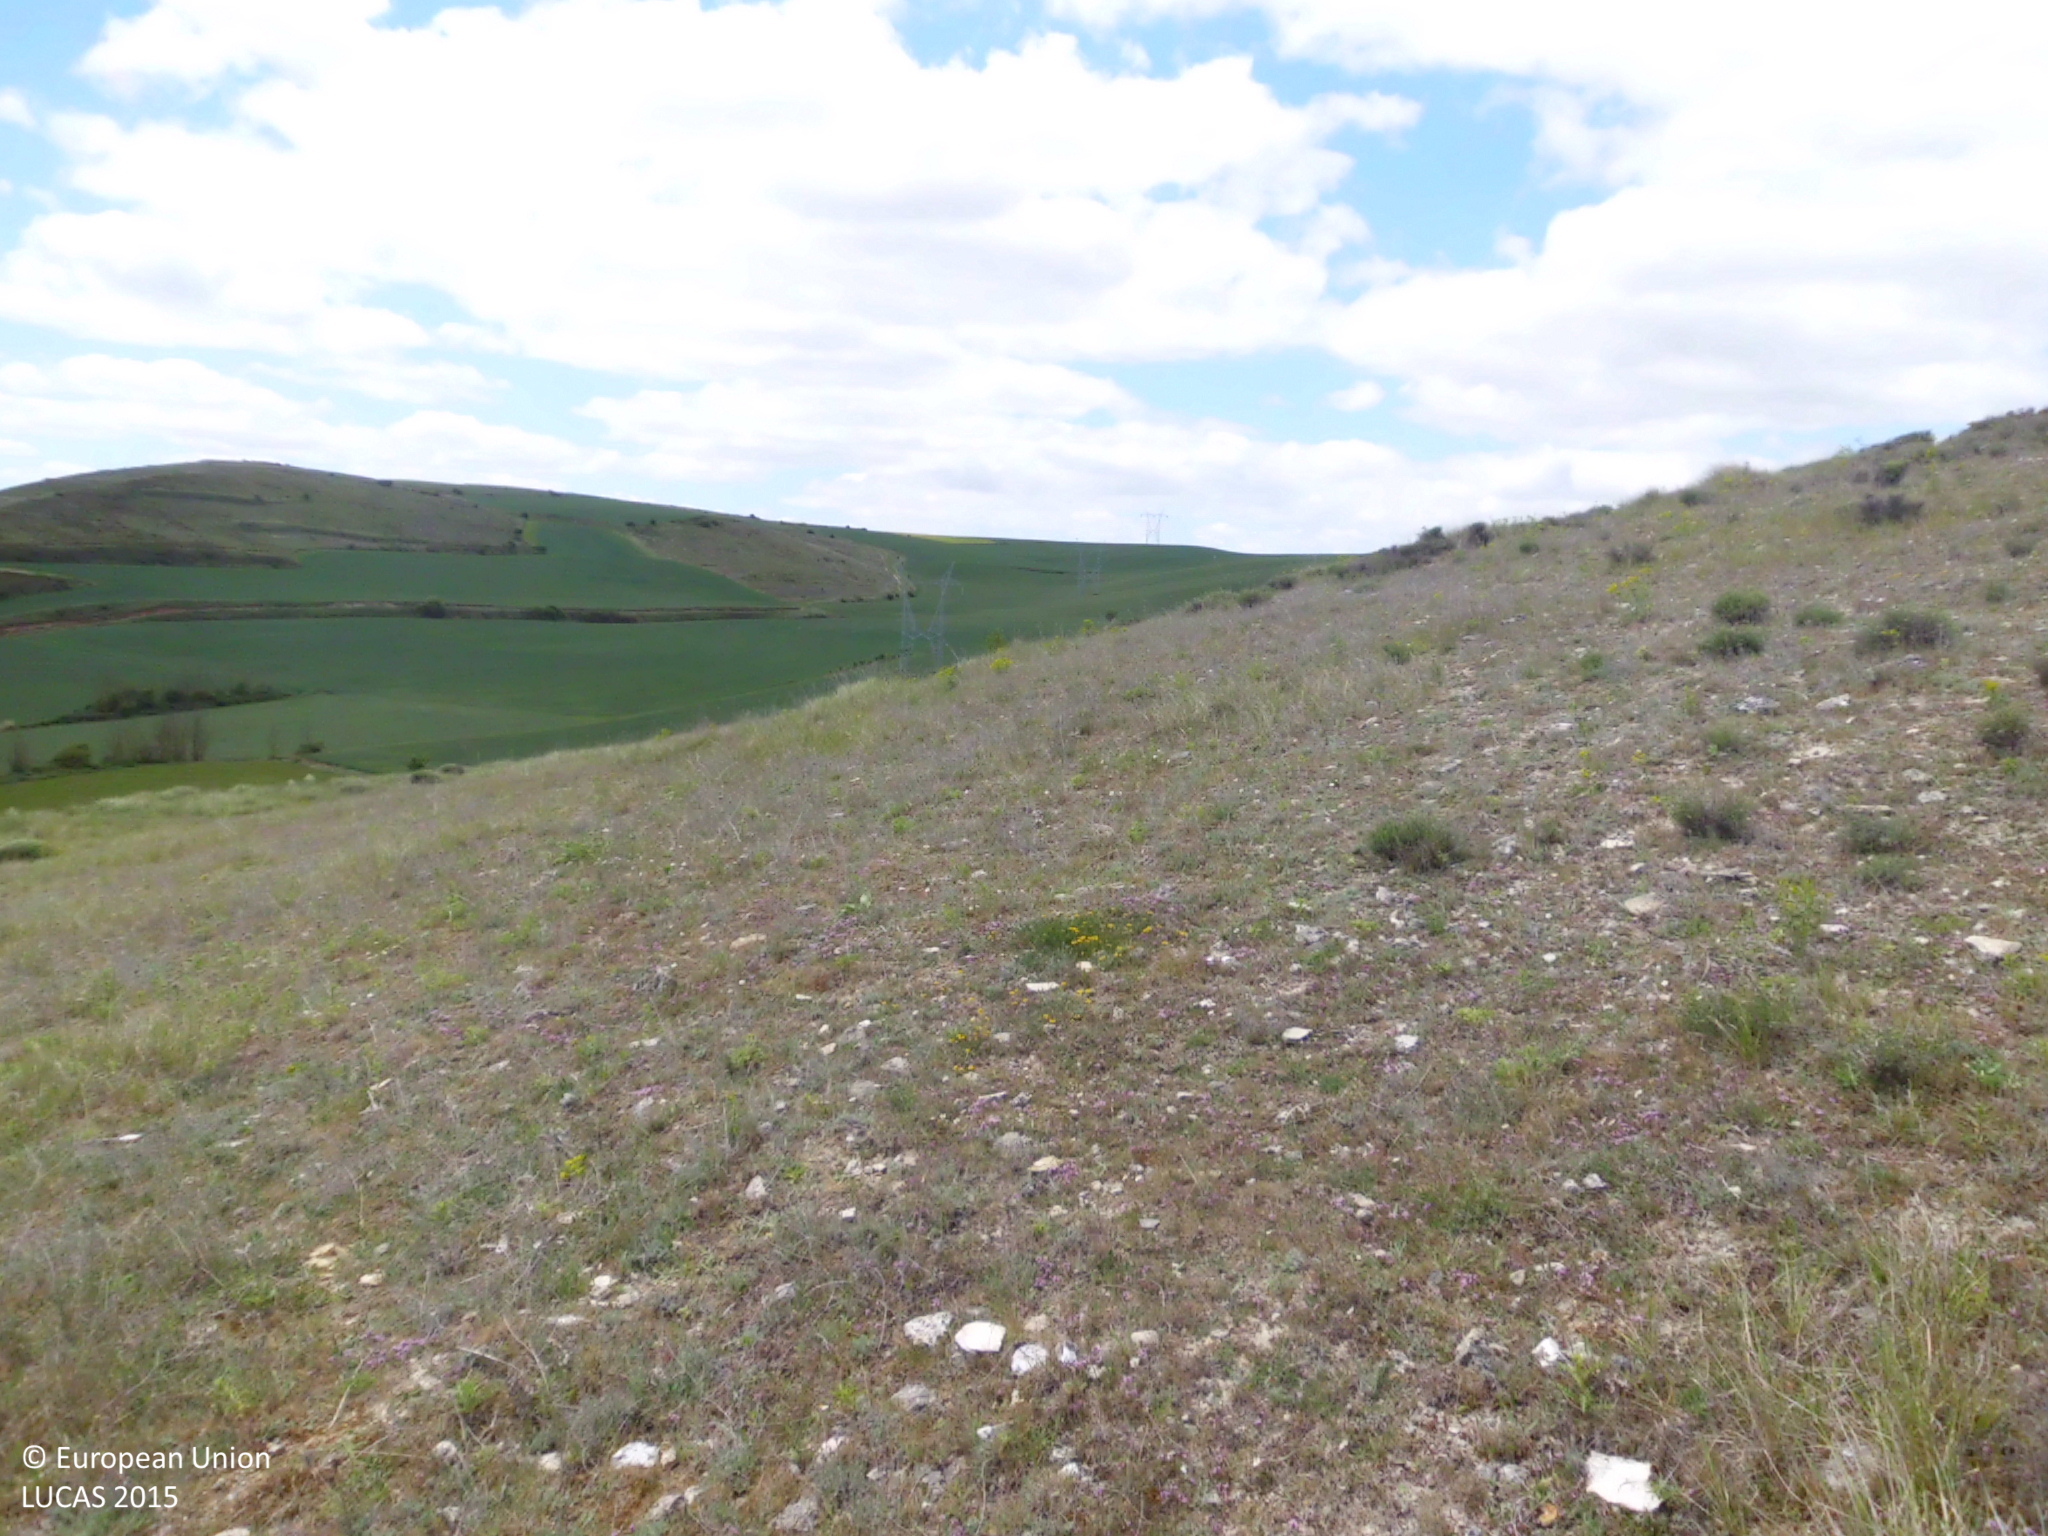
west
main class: Grassland
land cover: Grassland without tree/shrub cover
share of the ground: > 75 %
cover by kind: herbaceous plants 95 %, shrubs 5 %
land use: Semi-natural and natural areas not in use
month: May
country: ES
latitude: 42.3005
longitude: -3.8543
